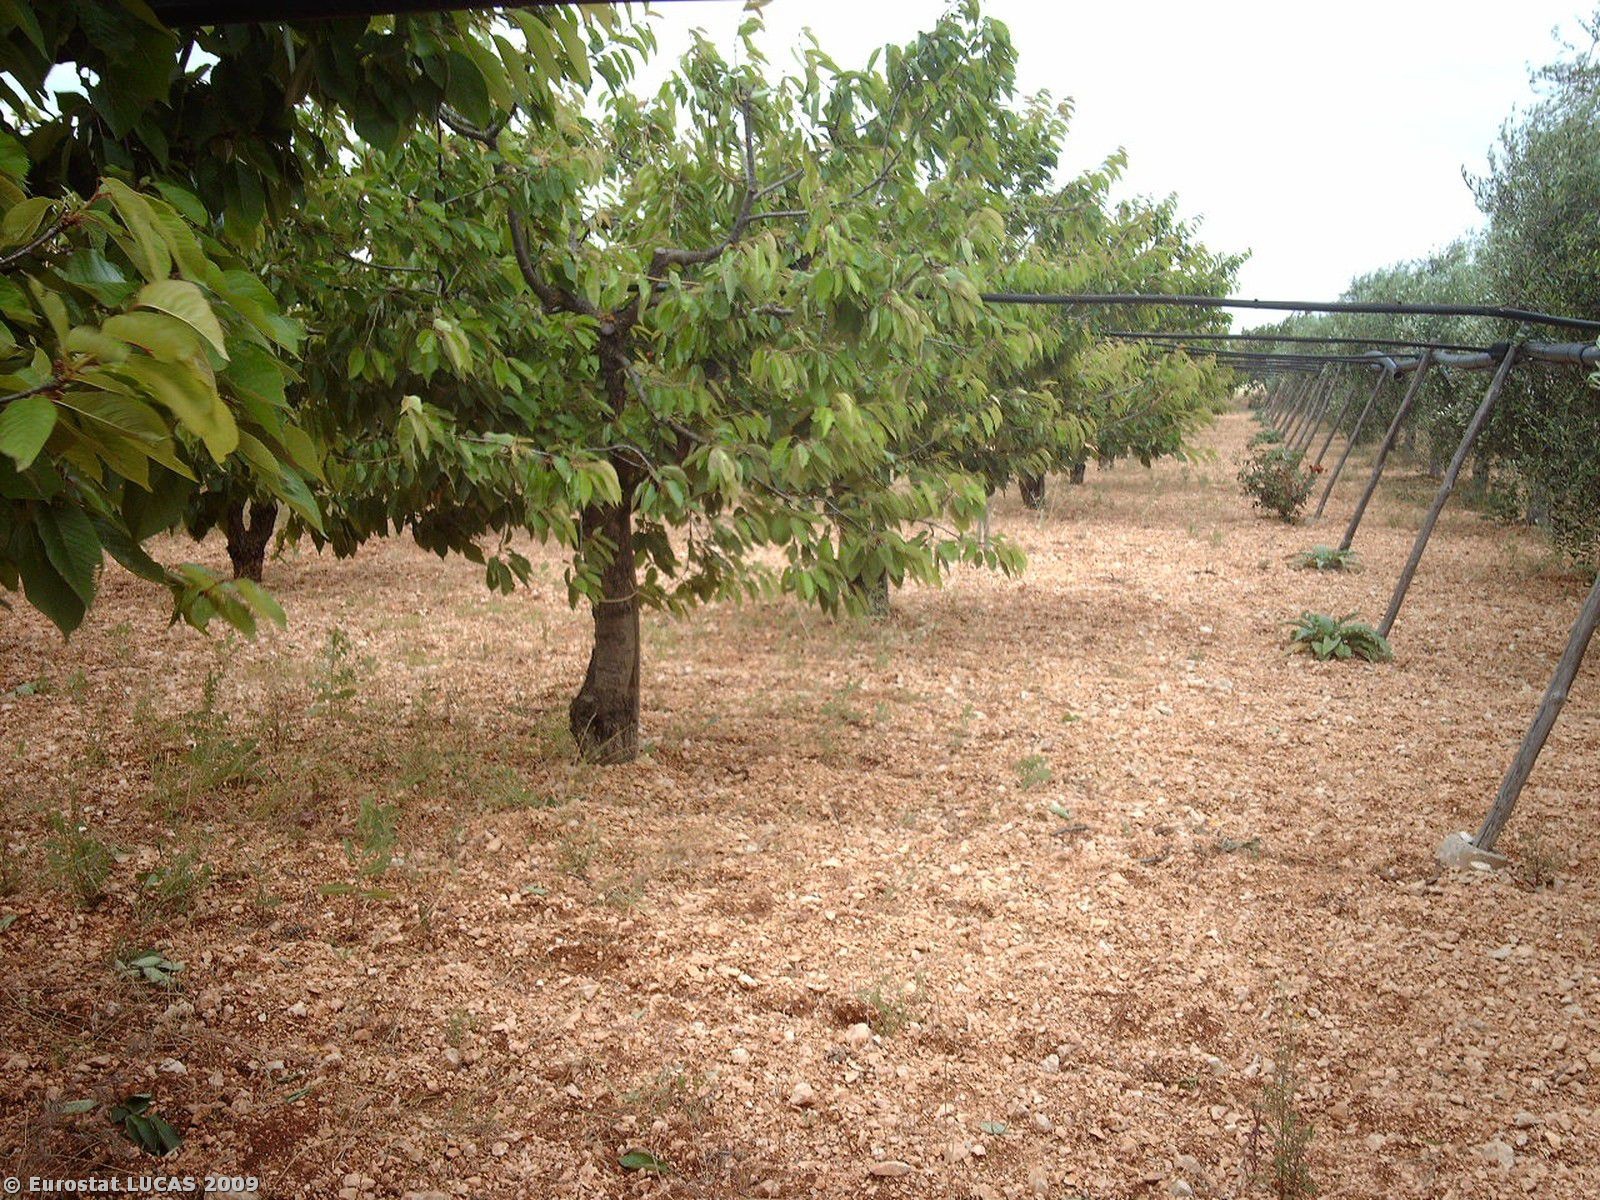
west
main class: Cropland
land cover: Cherry fruit
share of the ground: 25 - 50 %
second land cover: Olive groves
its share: 10 - 25 %
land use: Agriculture (excluding fallow land and kitchen gardens)
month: June
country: IT
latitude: 40.9936
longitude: 17.0517
